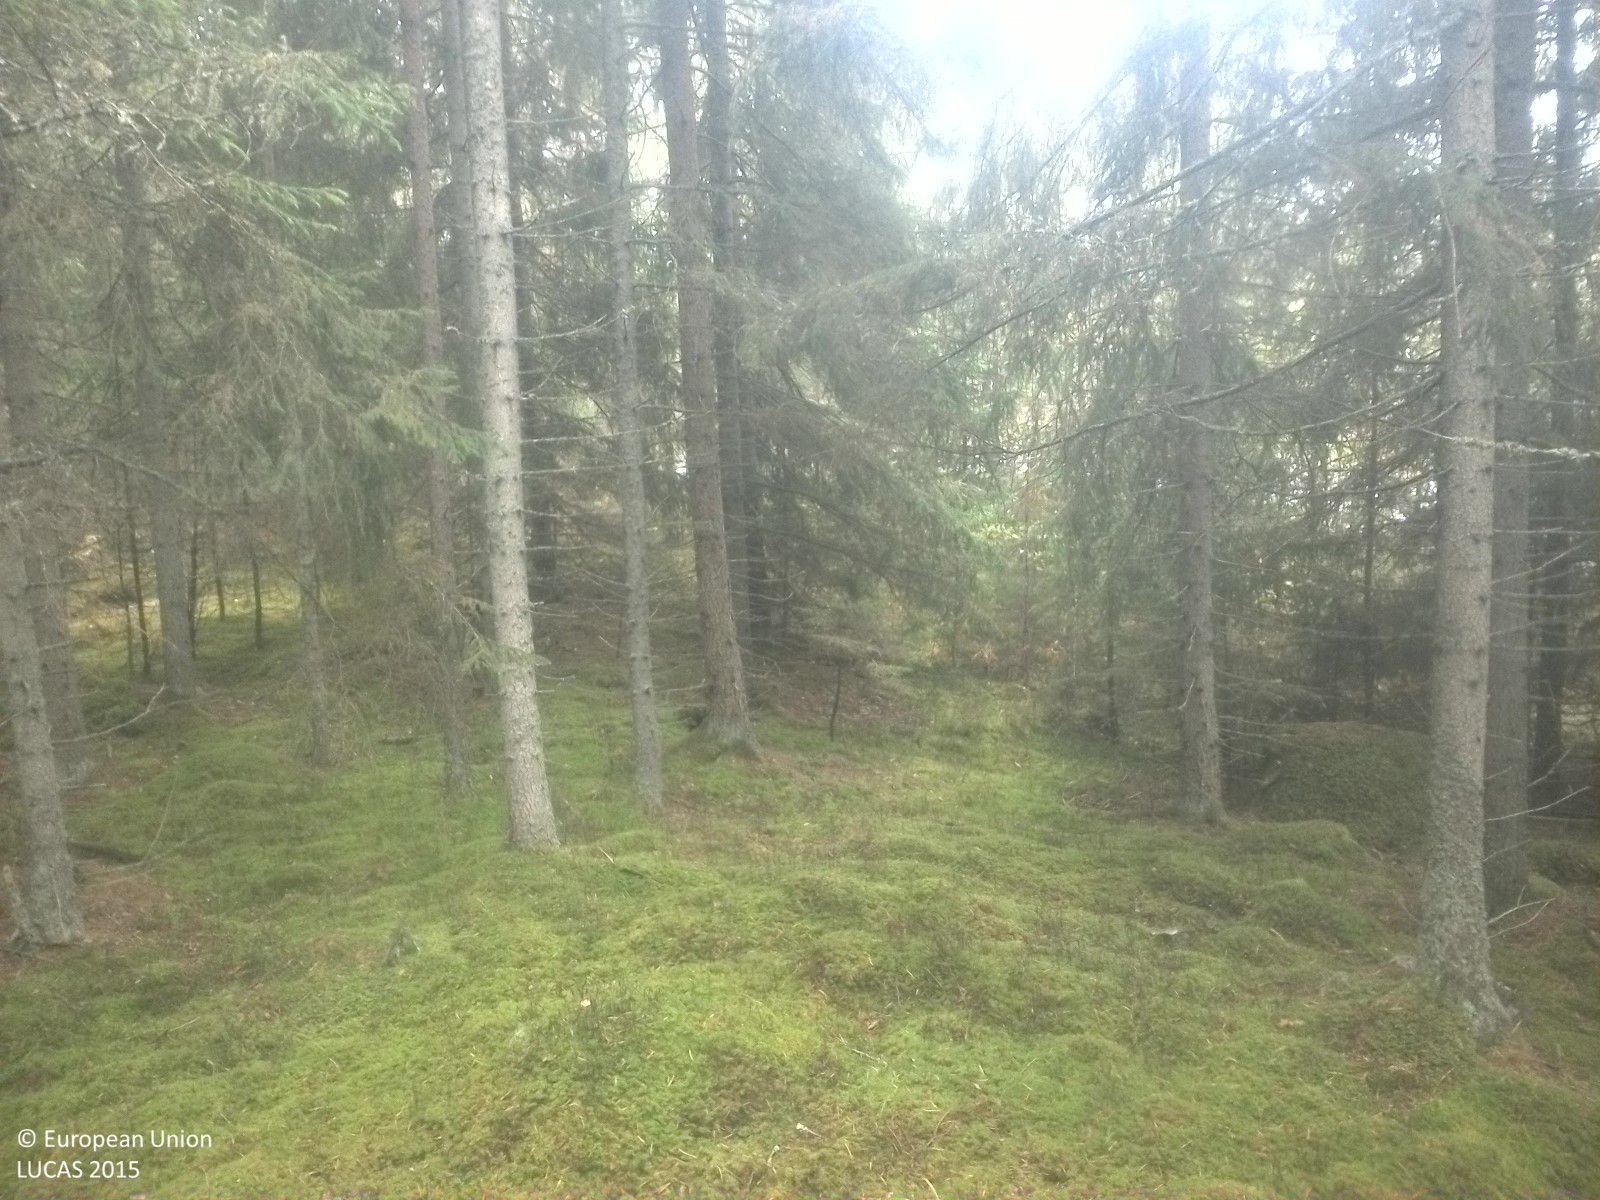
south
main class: Woodland
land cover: Spruce dominated coniferous woodland
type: boreal forest
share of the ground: 50 - 75 %
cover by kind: coniferous forest trees 60 %, lichens and mosses 30 %, herbaceous plants 10 %
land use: Forestry
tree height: > 5 m
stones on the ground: 10 - 25 %
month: September
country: SE
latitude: 58.7969
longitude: 15.8257
